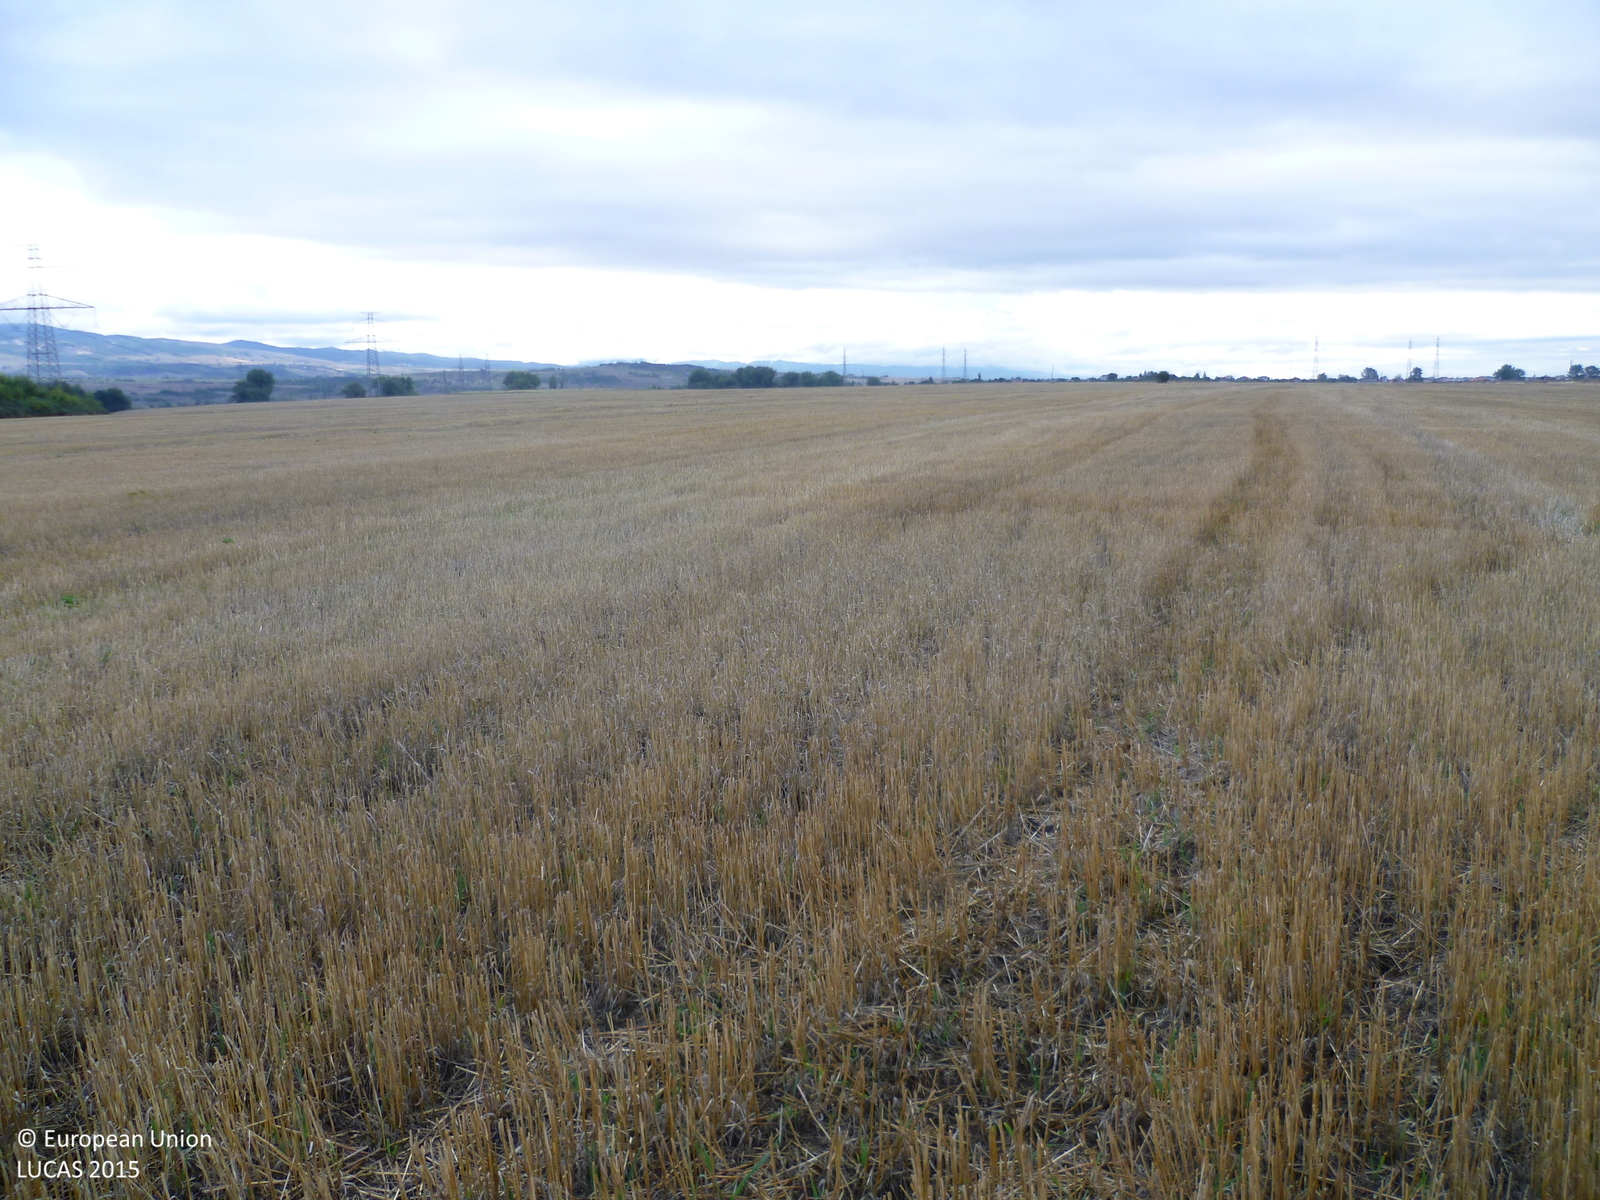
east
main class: Cropland
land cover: Rye
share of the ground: > 75 %
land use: Agriculture (excluding fallow land and kitchen gardens)
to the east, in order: Rye
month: September
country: BG
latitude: 42.8327
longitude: 23.1599
